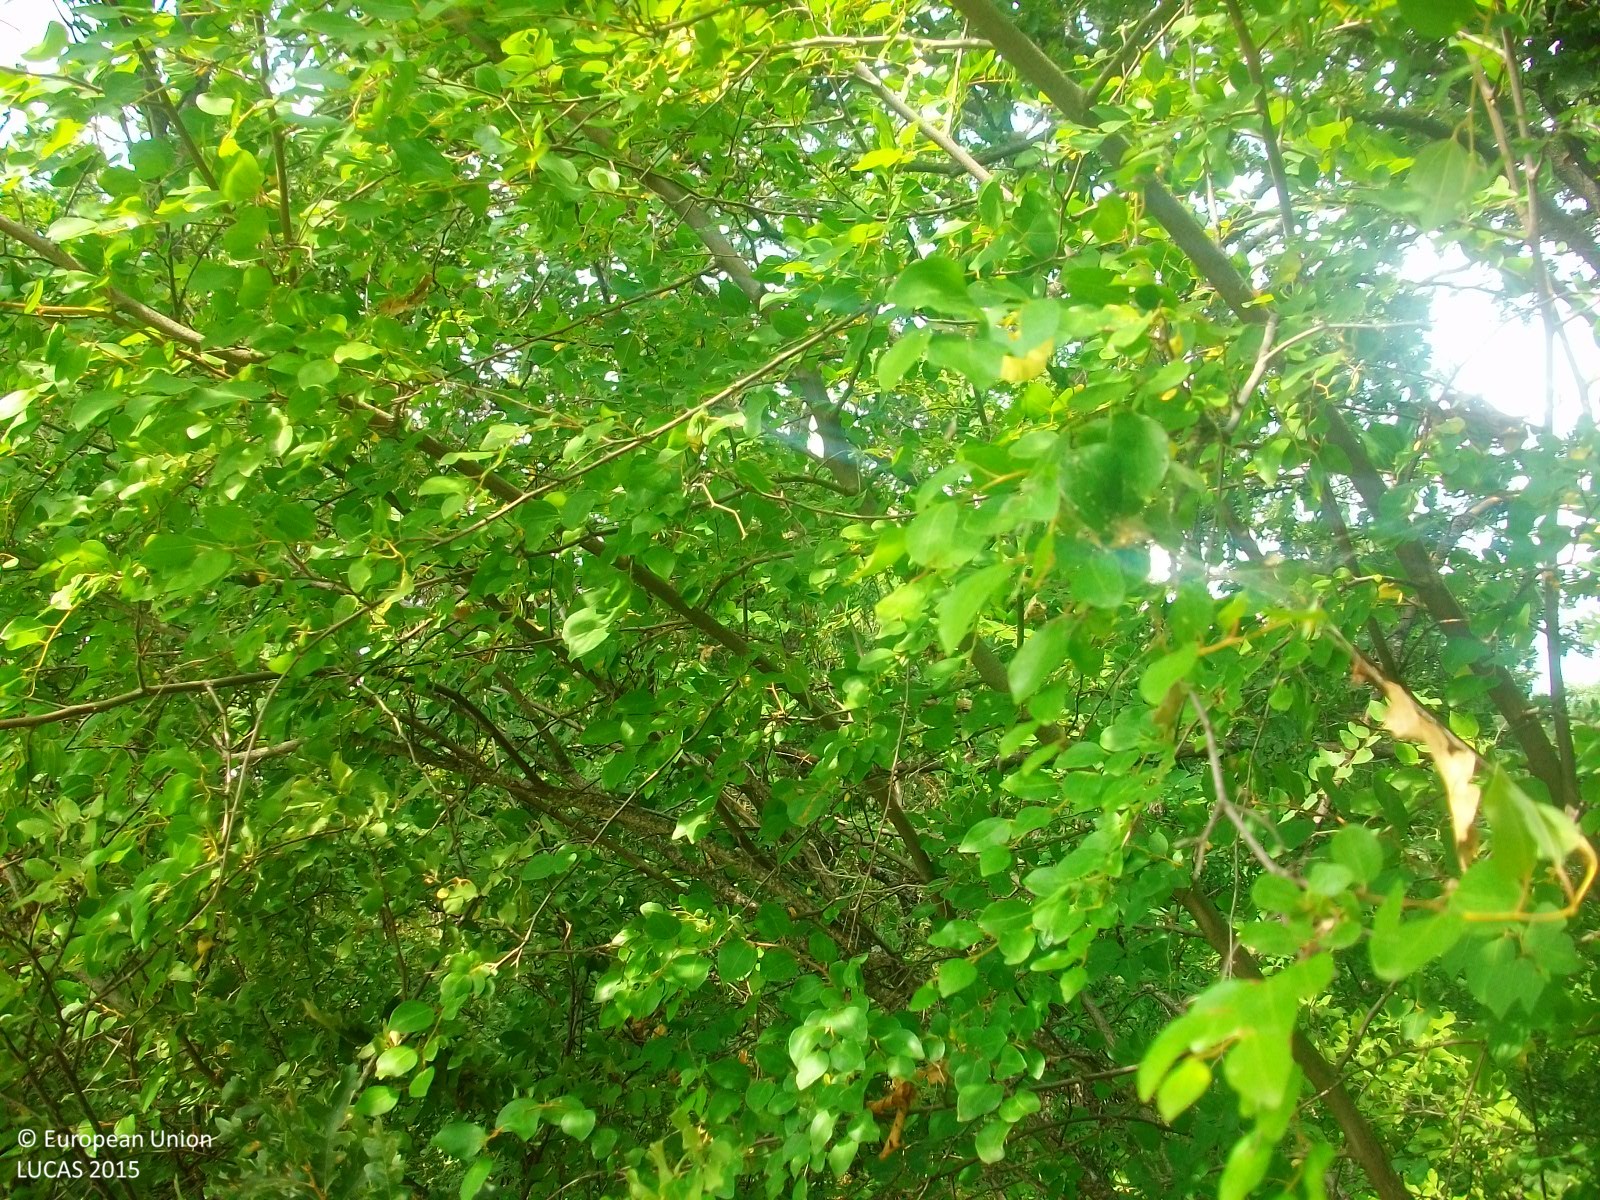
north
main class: Woodland
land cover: Broadleaved woodland
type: thermophilous deciduous forest
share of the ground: > 75 %
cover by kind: broadleaved forest trees 90 %, shrubs 10 %
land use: Semi-natural and natural areas not in use
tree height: > 5 m
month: August
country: GR
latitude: 41.3022
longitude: 26.2047
